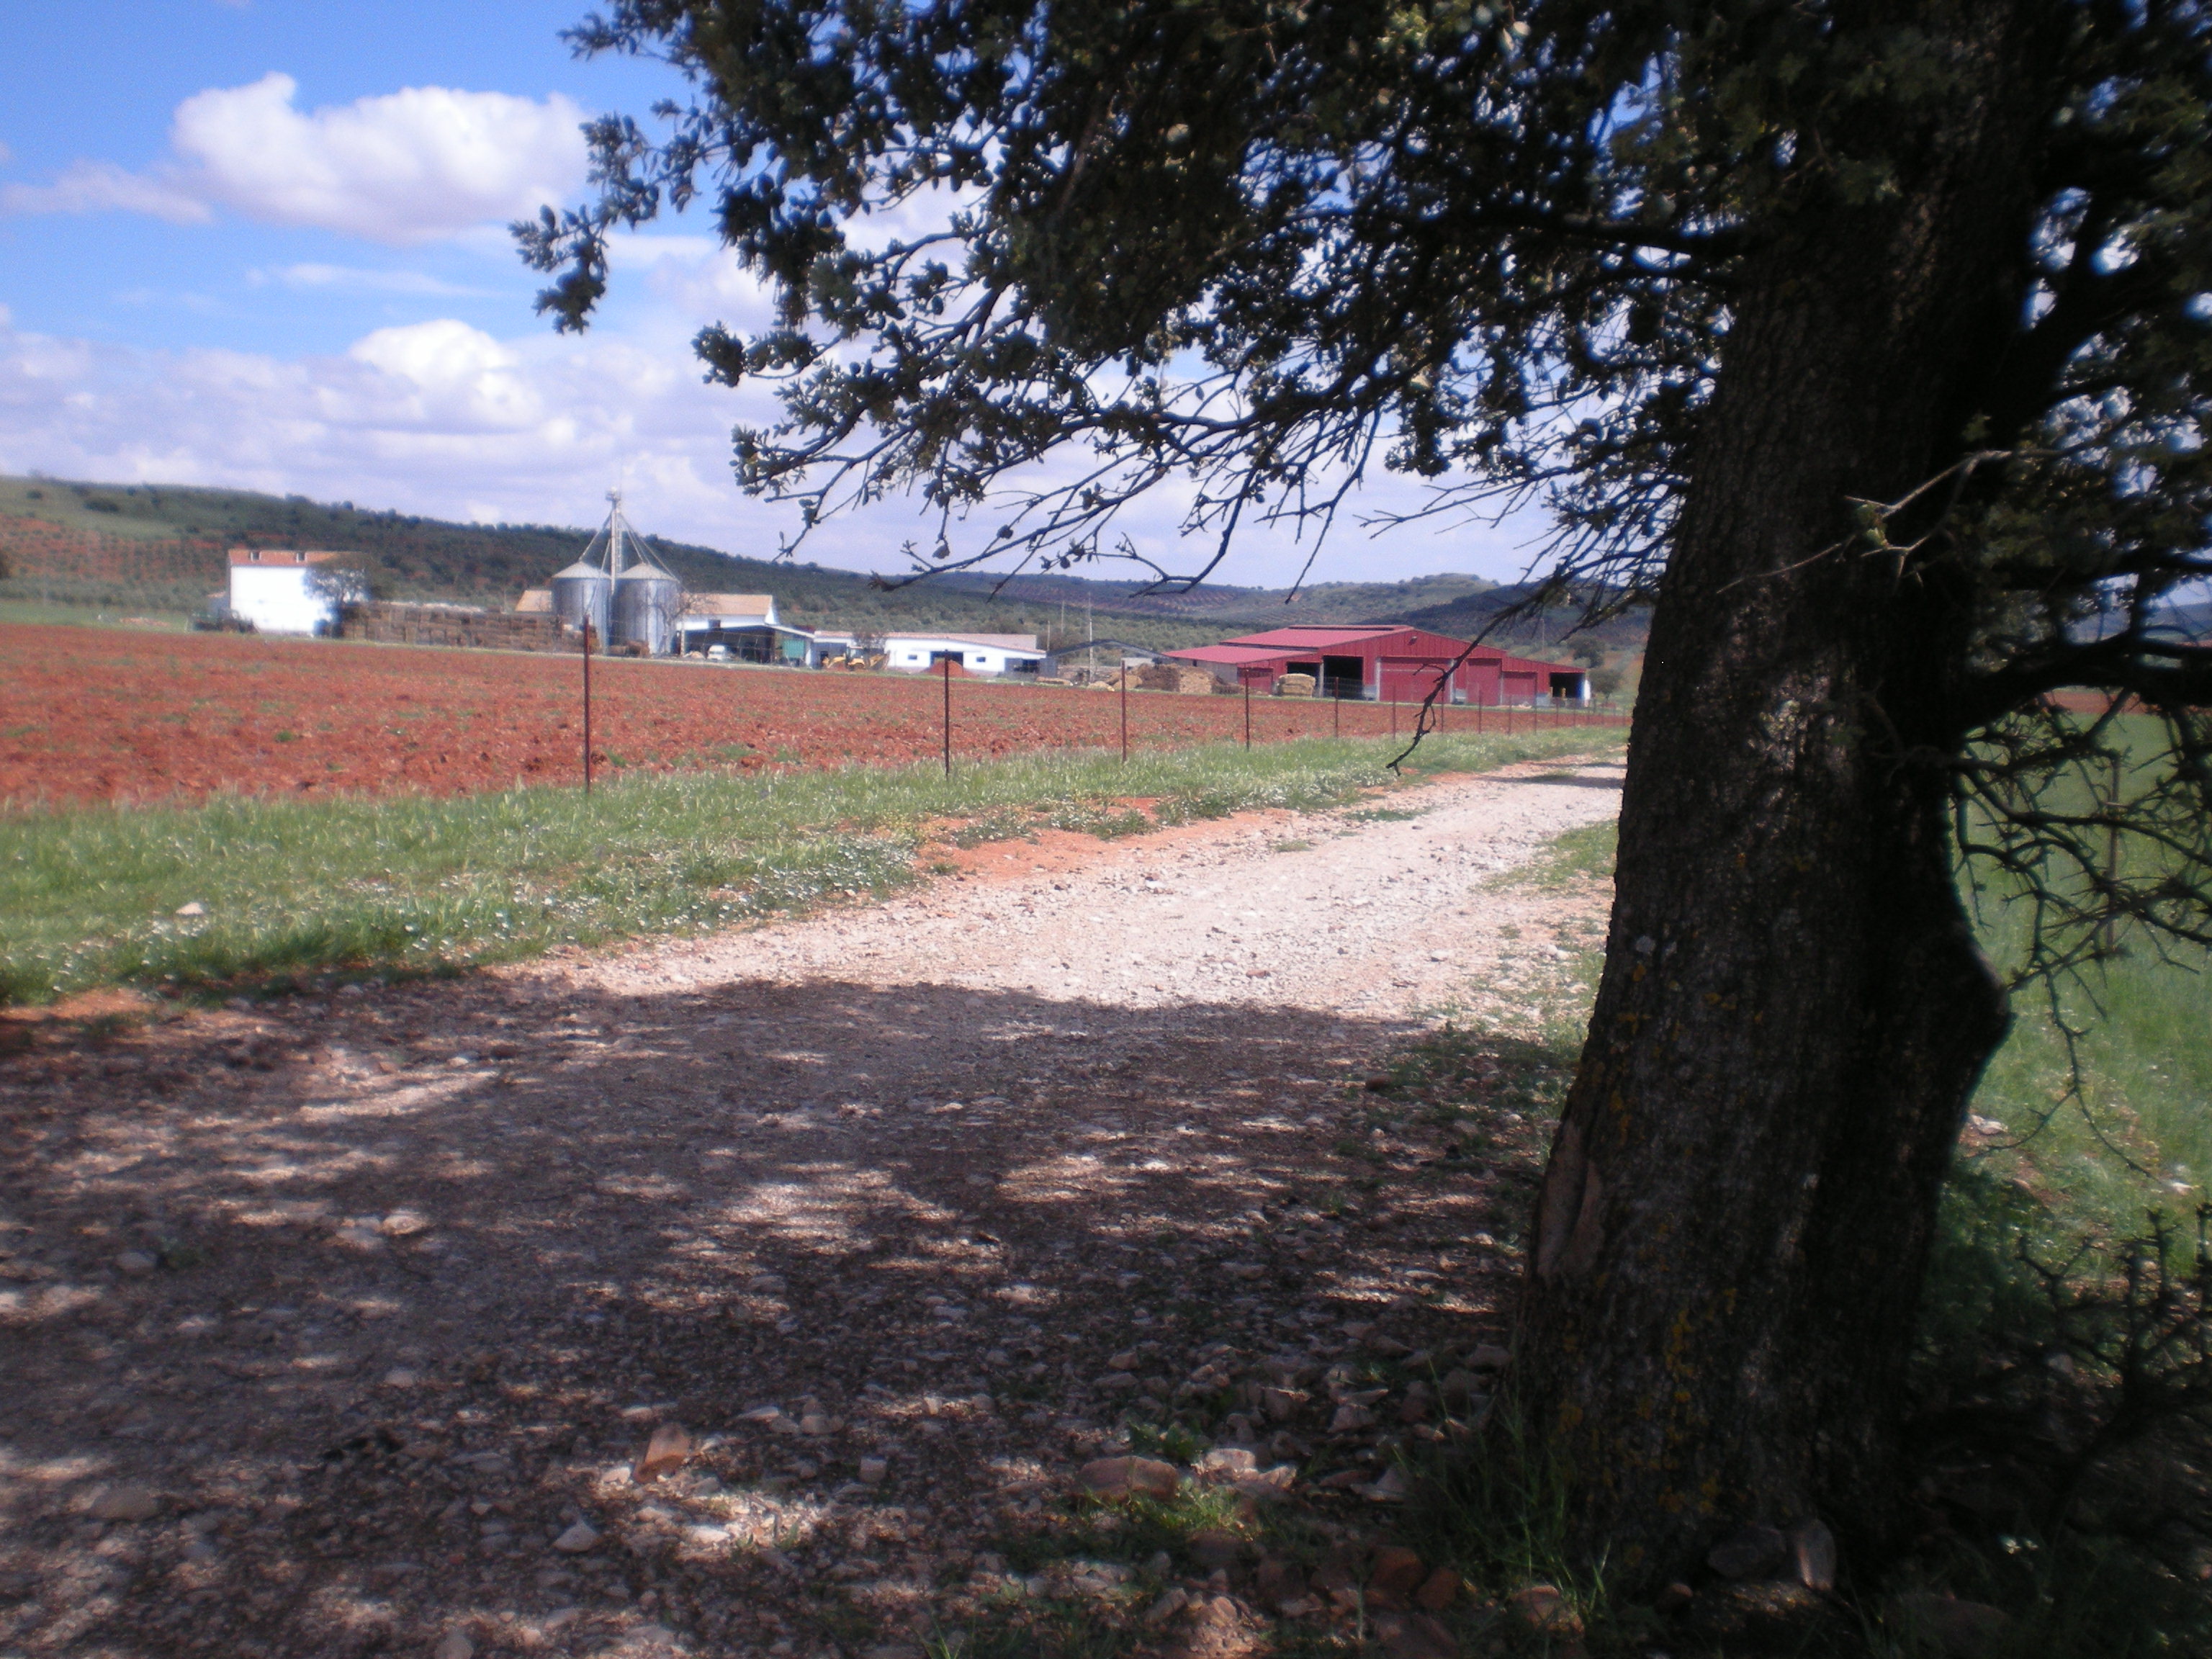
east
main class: Cropland
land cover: Common wheat
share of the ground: > 75 %
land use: Agriculture (excluding fallow land and kitchen gardens)
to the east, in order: Common wheat; Fences; Lines of trees; Grass margins; Tracks; Grass margins; Fences; Other bare soil; Grass margins; Fences; Grassland without tree/shrub cover; Artificial constructions in urban areas
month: April
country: ES
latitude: 38.7503
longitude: -3.5789
